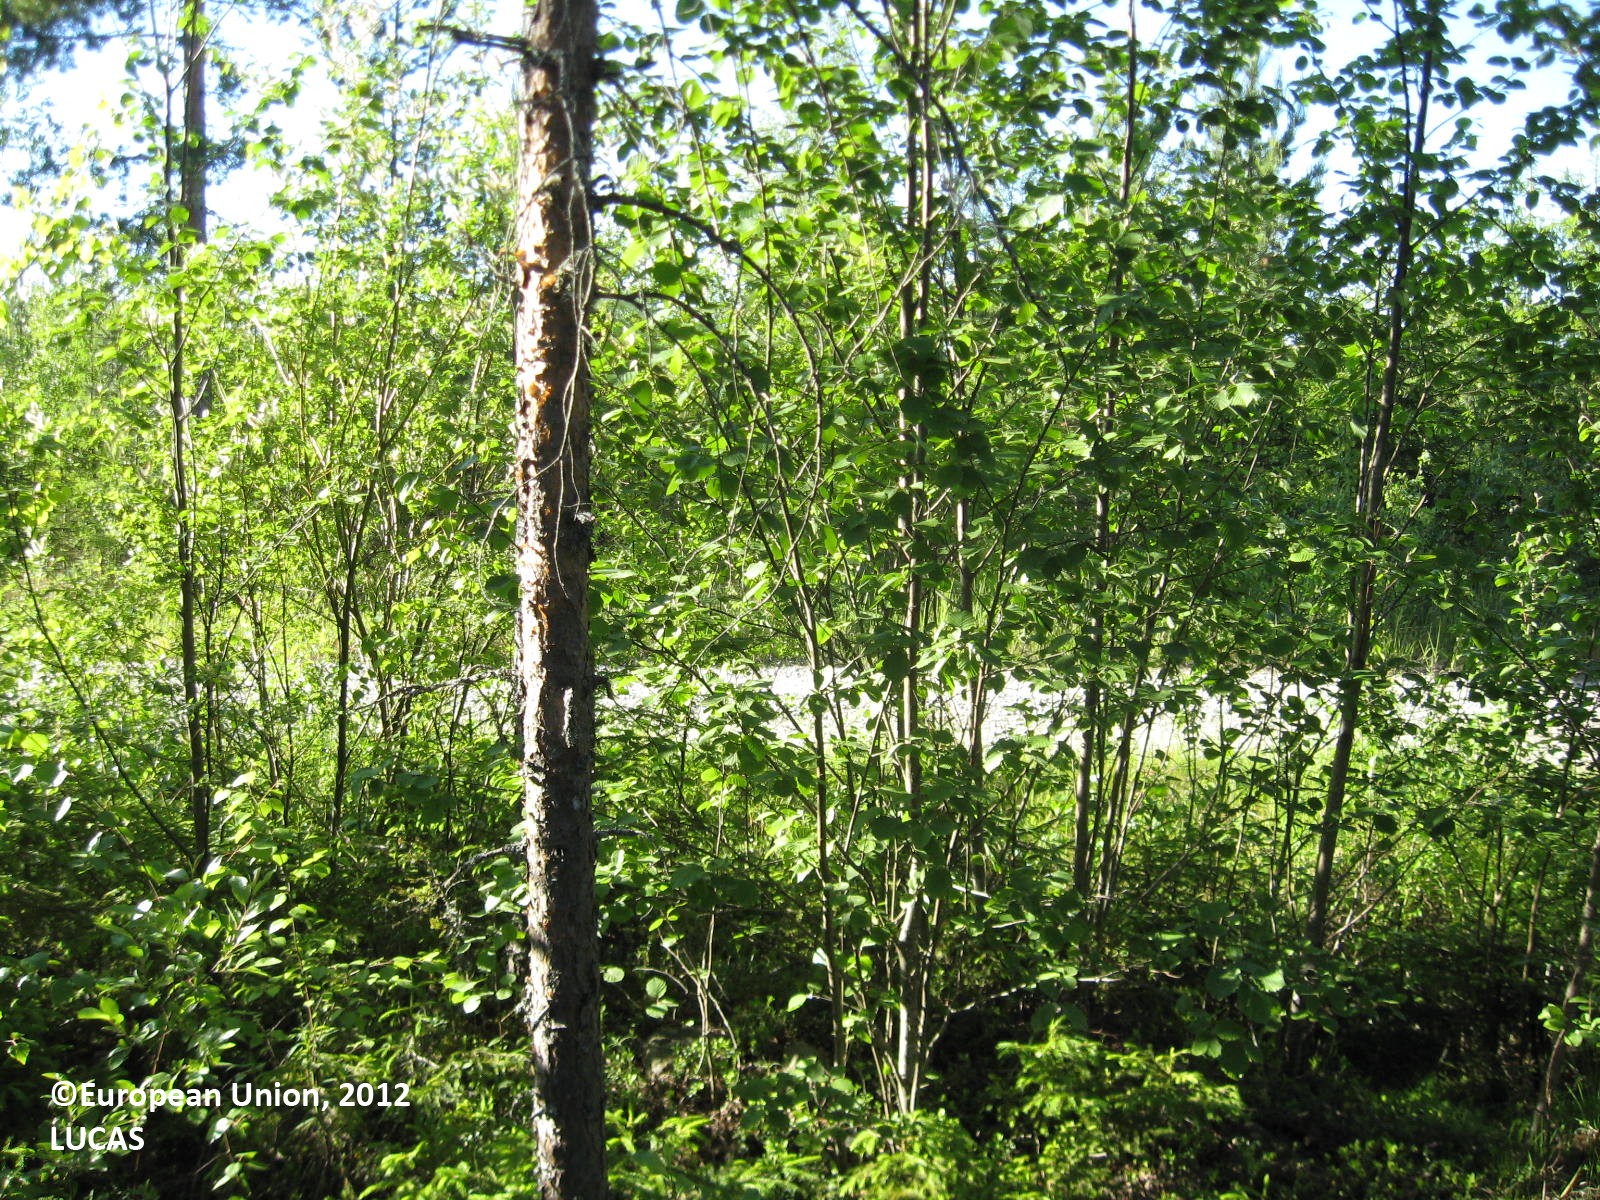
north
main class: Woodland
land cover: Pine dominated coniferous woodland
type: boreal forest
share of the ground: > 75 %
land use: Forestry
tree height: > 5 m
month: June
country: FI
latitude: 62.8229
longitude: 21.5614
